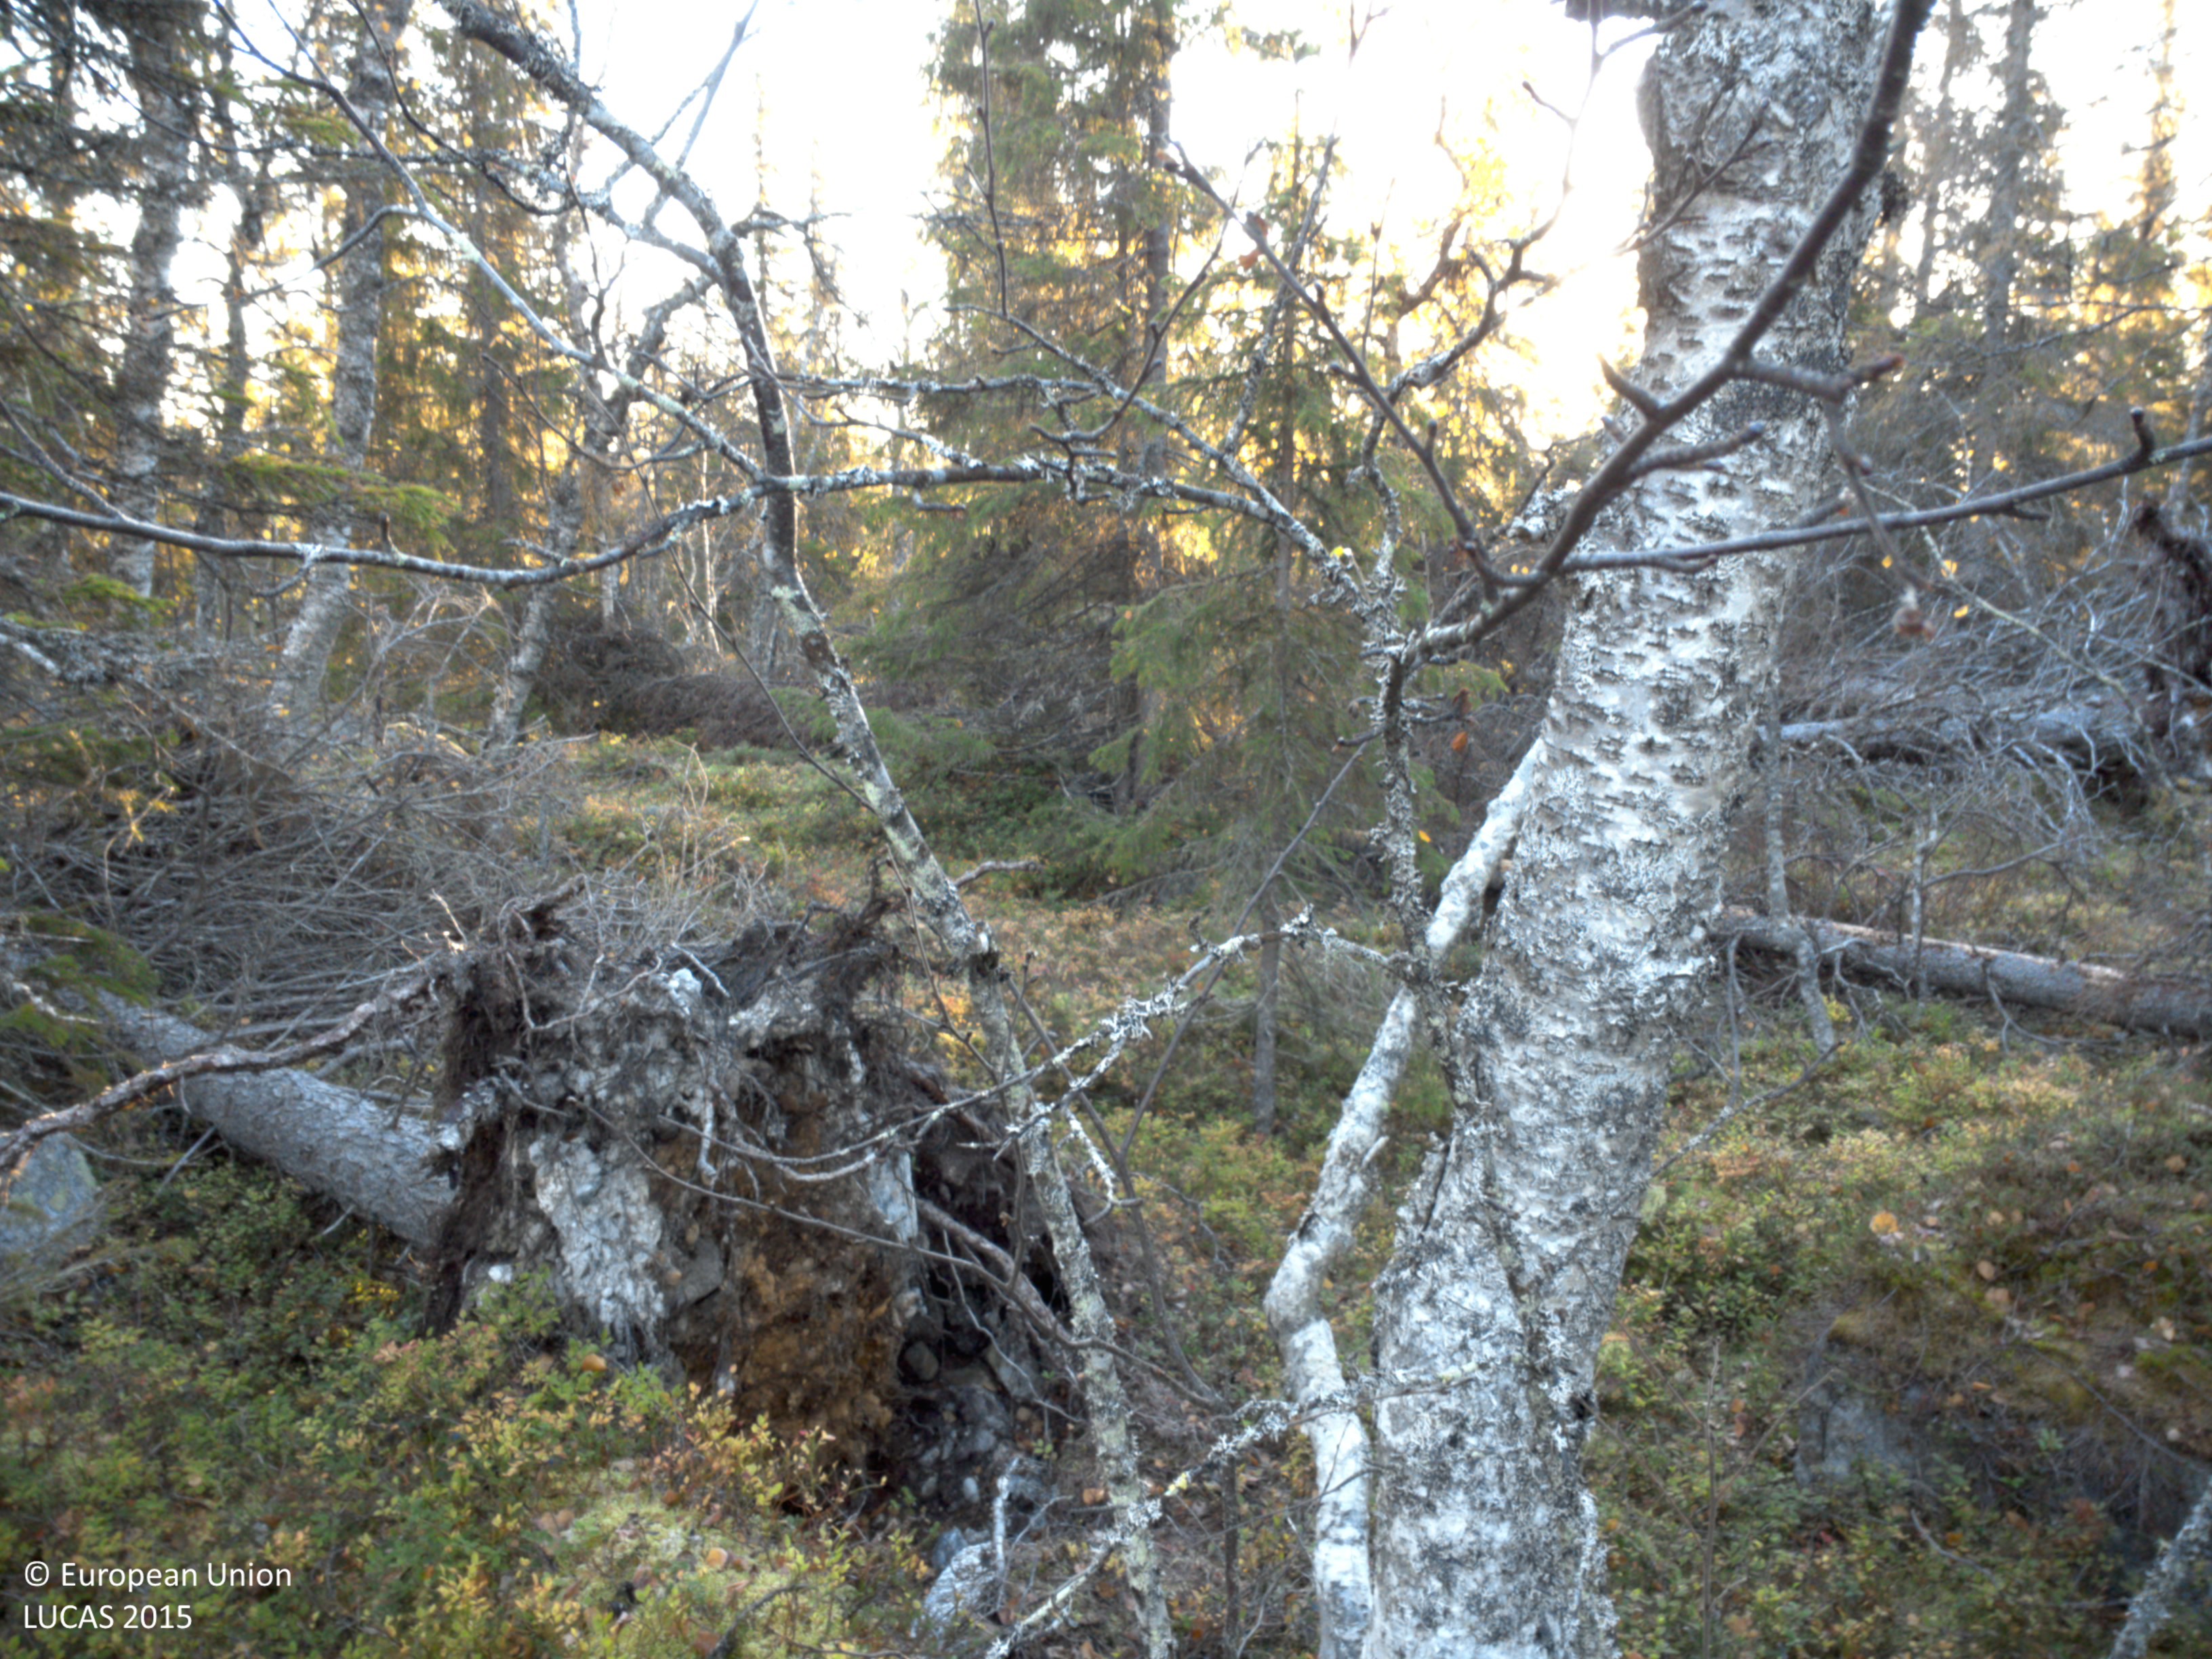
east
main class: Woodland
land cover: Spruce dominated mixed woodland
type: boreal forest
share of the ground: 50 - 75 %
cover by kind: coniferous forest trees 45 %, shrubs 40 %, broadleaved forest trees 15 %
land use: Forestry
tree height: > 5 m
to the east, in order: Spruce dominated mixed woodland
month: October
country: SE
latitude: 64.5359
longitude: 17.7425
